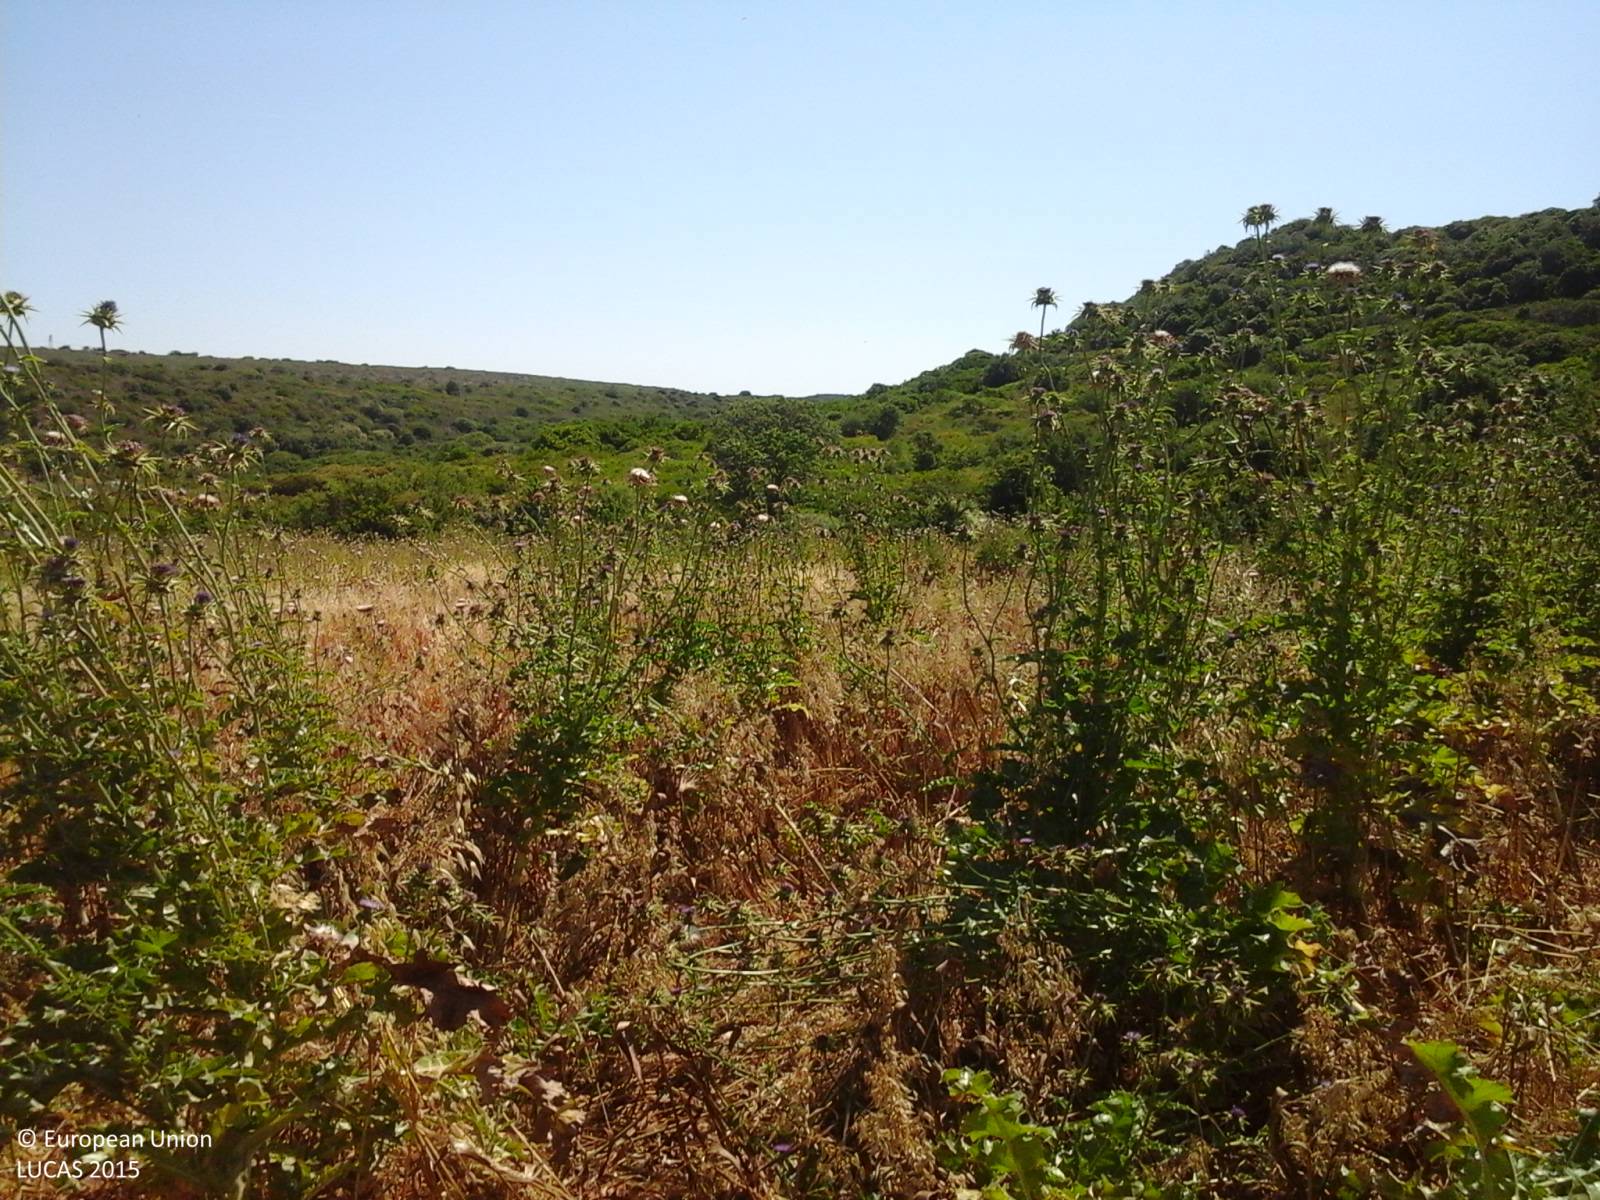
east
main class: Grassland
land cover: Spontaneously vegetated surfaces
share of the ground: 50 - 75 %
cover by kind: herbaceous plants 100 %
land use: Agriculture (excluding fallow land and kitchen gardens)
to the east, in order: Spontaneously vegetated surfaces; Shrubland with sparse tree cover; Grassland without tree/shrub cover; Broadleaved woodland
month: June
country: IT
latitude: 40.6712
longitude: 8.4342
